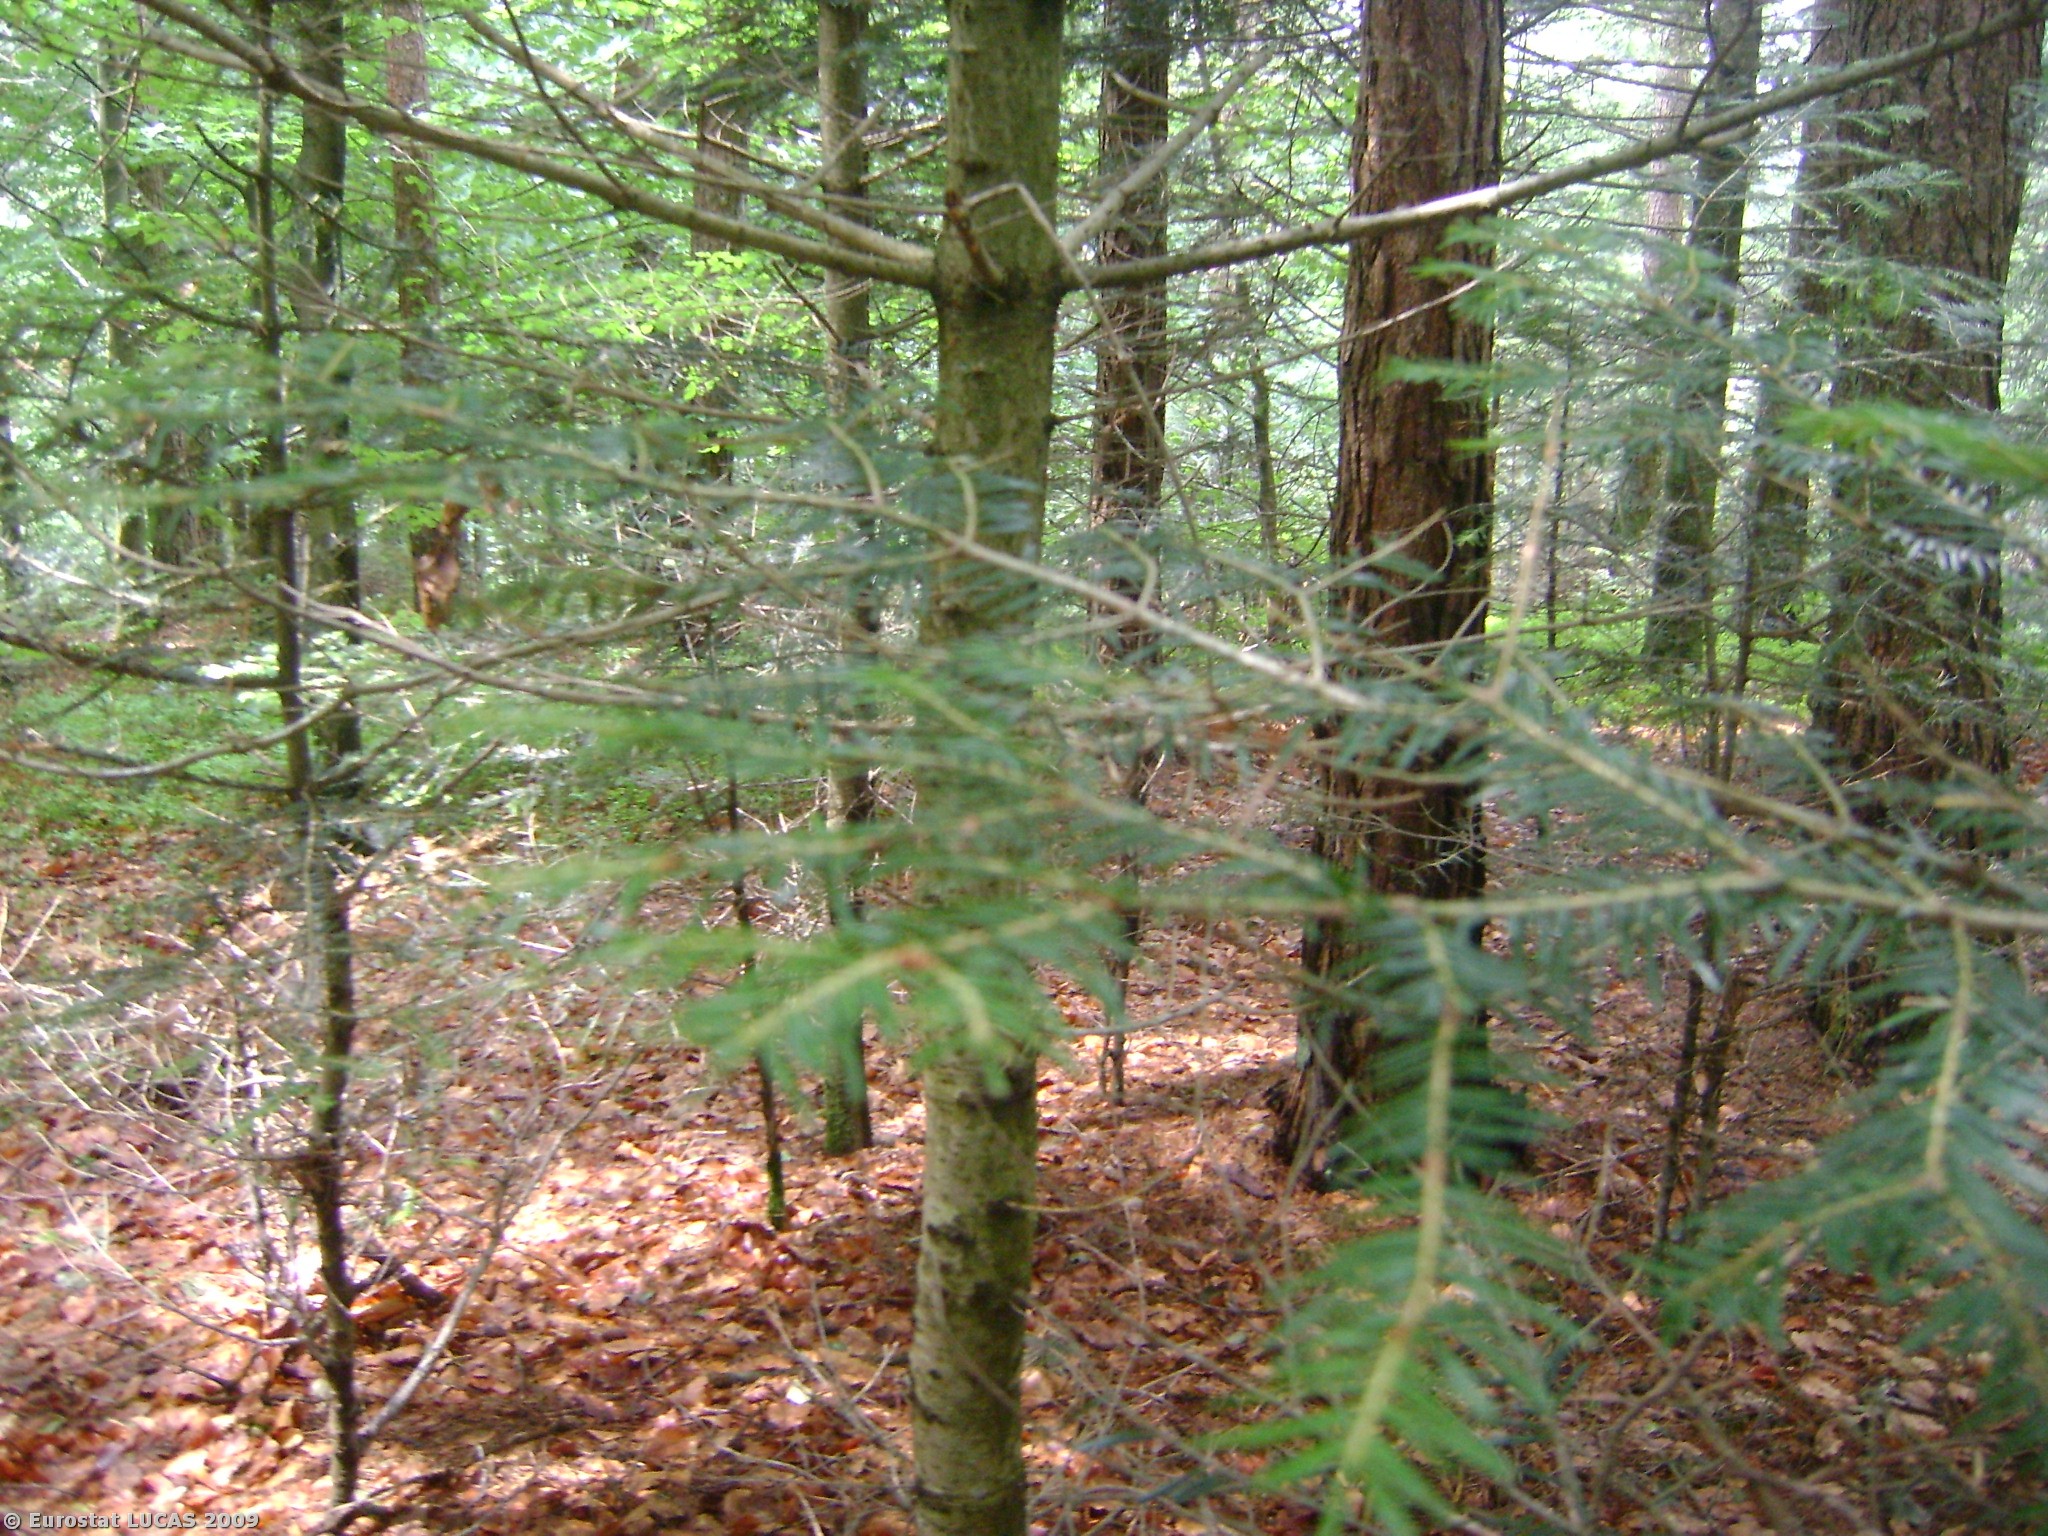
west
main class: Woodland
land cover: Mixed woodland
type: hemiboreal forest and nemoral coniferous forest and mixed broadleaved-coniferous forest
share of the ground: > 75 %
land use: Forestry
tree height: > 5 m
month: June
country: AT
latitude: 48.1392
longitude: 13.2647
